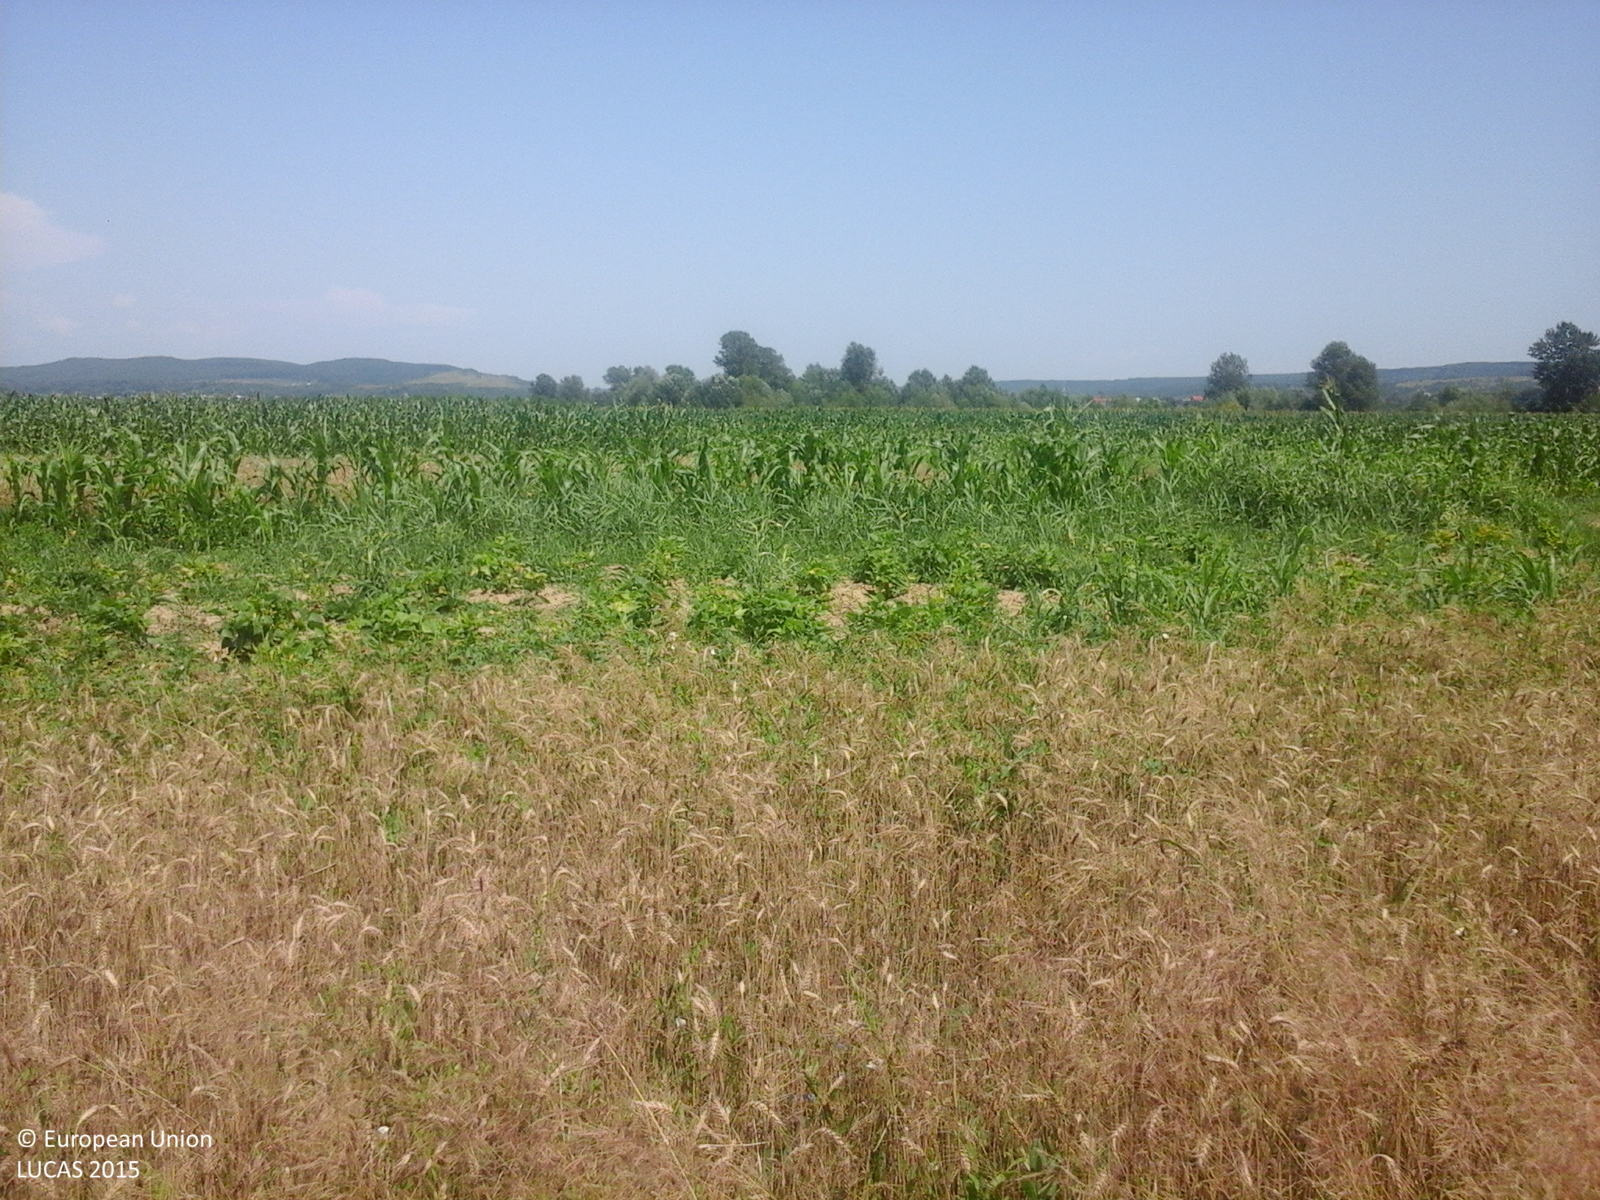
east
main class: Cropland
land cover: Common wheat
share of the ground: > 75 %
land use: Agriculture (excluding fallow land and kitchen gardens)
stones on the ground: < 10 %
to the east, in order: Common wheat; Other fresh vegetables; Grass margins; Maize; Common wheat; Grass margins; Tracks; Grass margins; Maize; Other fresh vegetables; Grass margins; Tracks; Grass margins; Maize; Grass margins; Maize; Common wheat; Maize; Rye; Maize
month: July
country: RO
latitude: 44.9665
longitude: 24.9303
